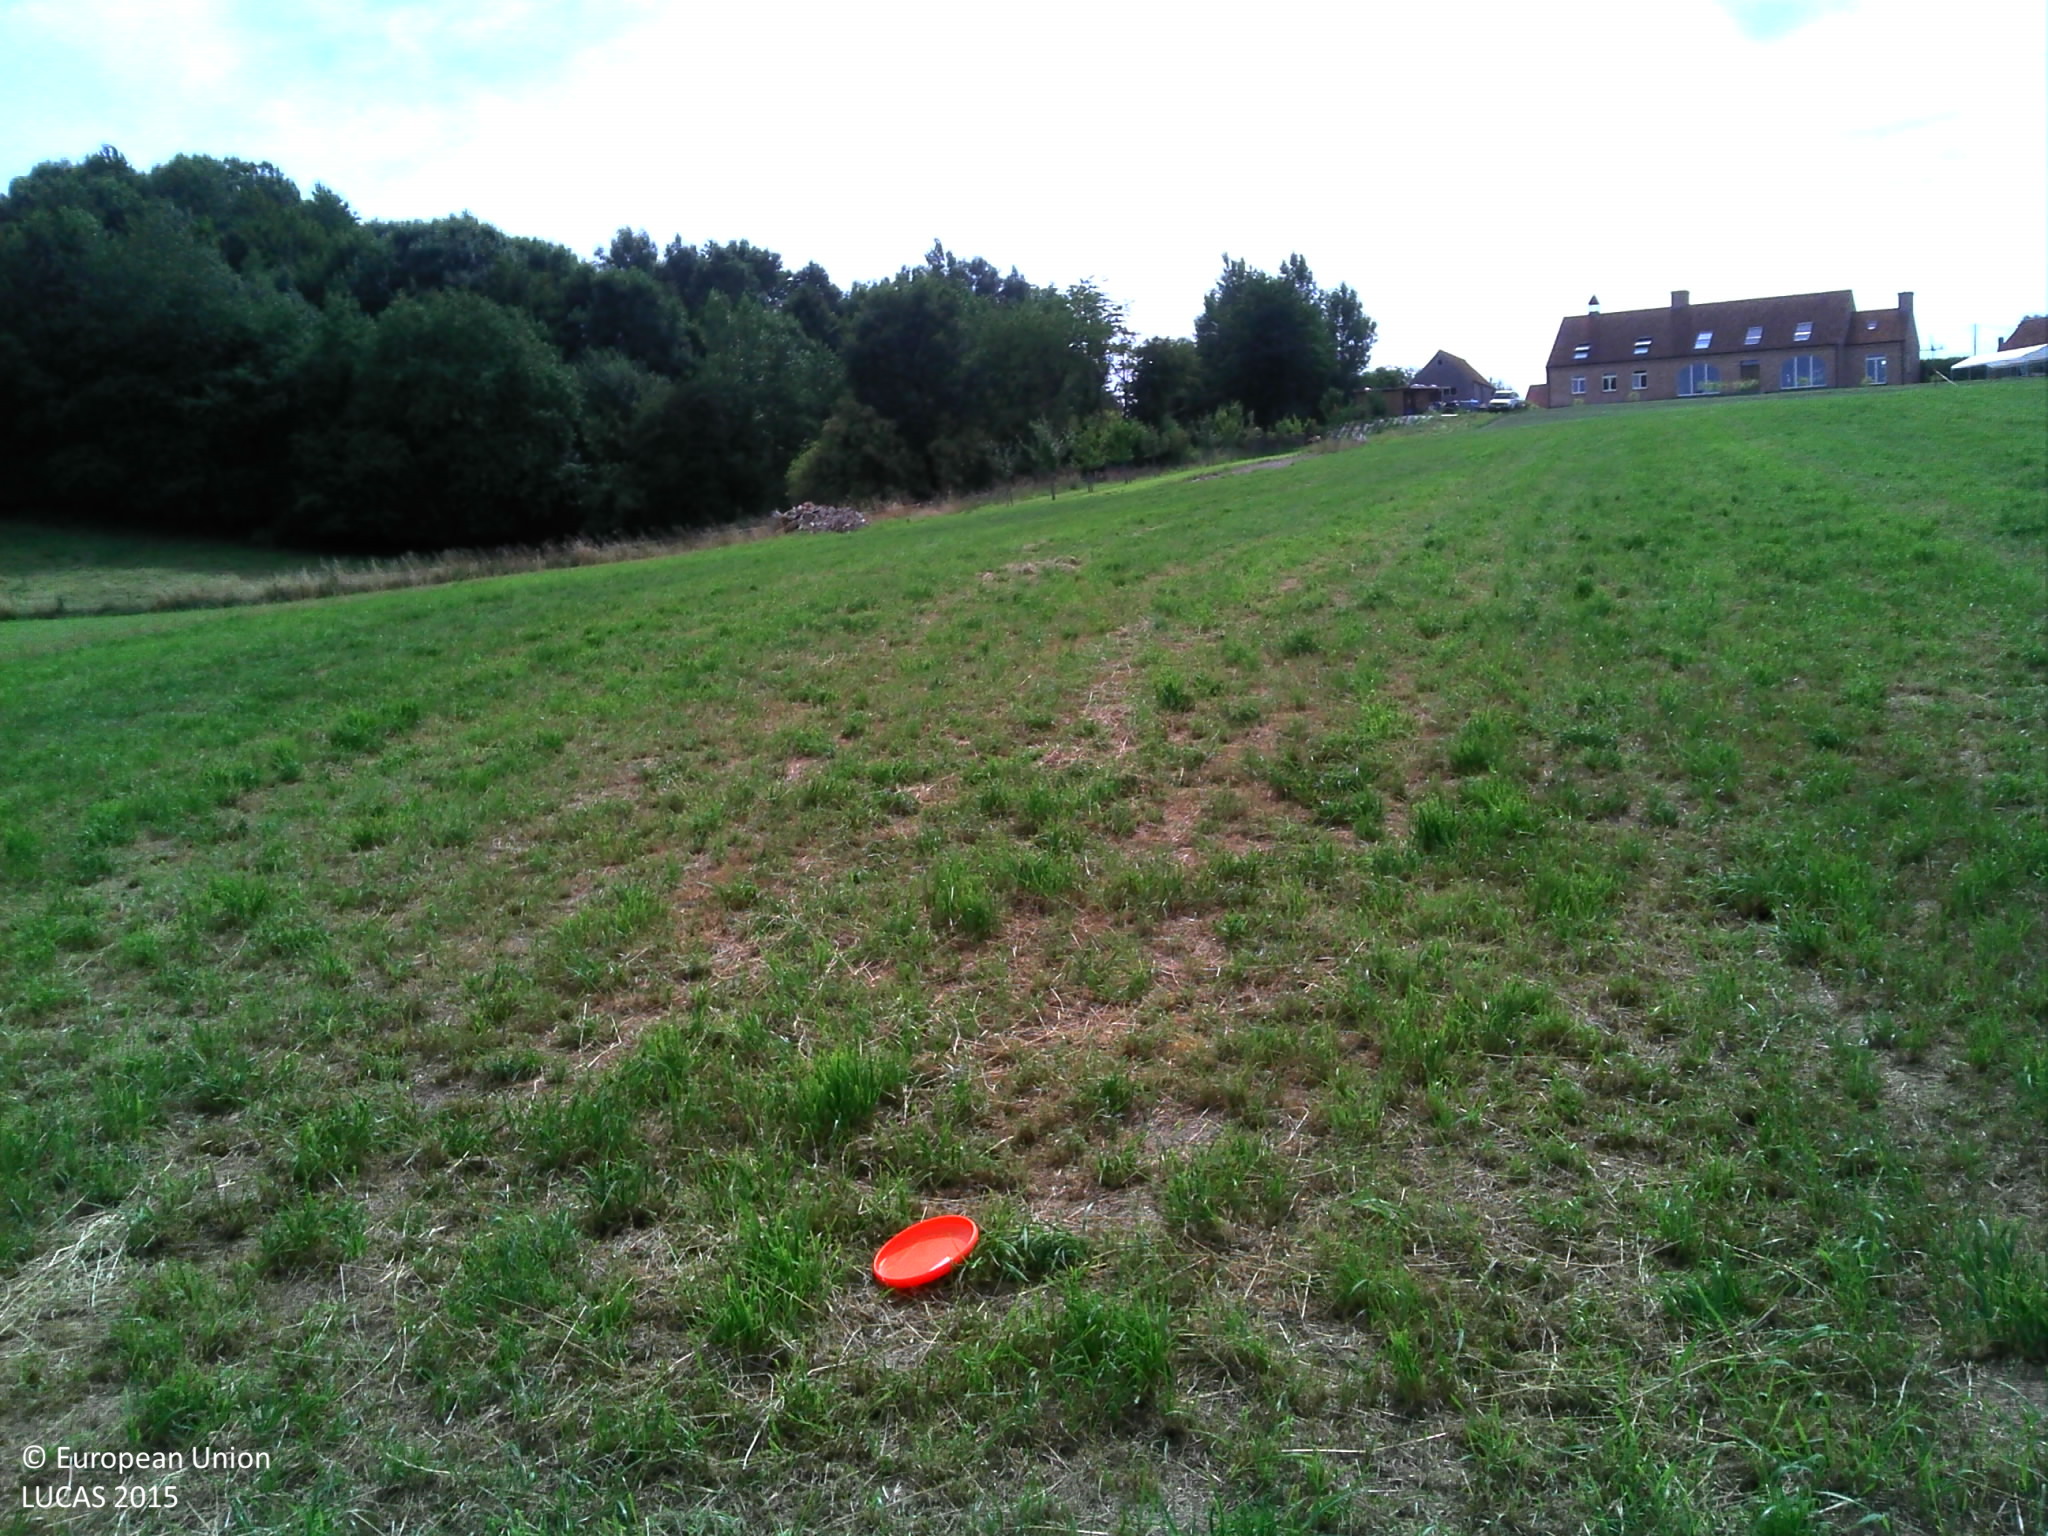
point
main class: Grassland
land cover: Grassland without tree/shrub cover
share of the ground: > 75 %
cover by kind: herbaceous plants 100 %
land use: Agriculture (excluding fallow land and kitchen gardens)
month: August
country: BE
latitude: 50.7487
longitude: 3.6860
